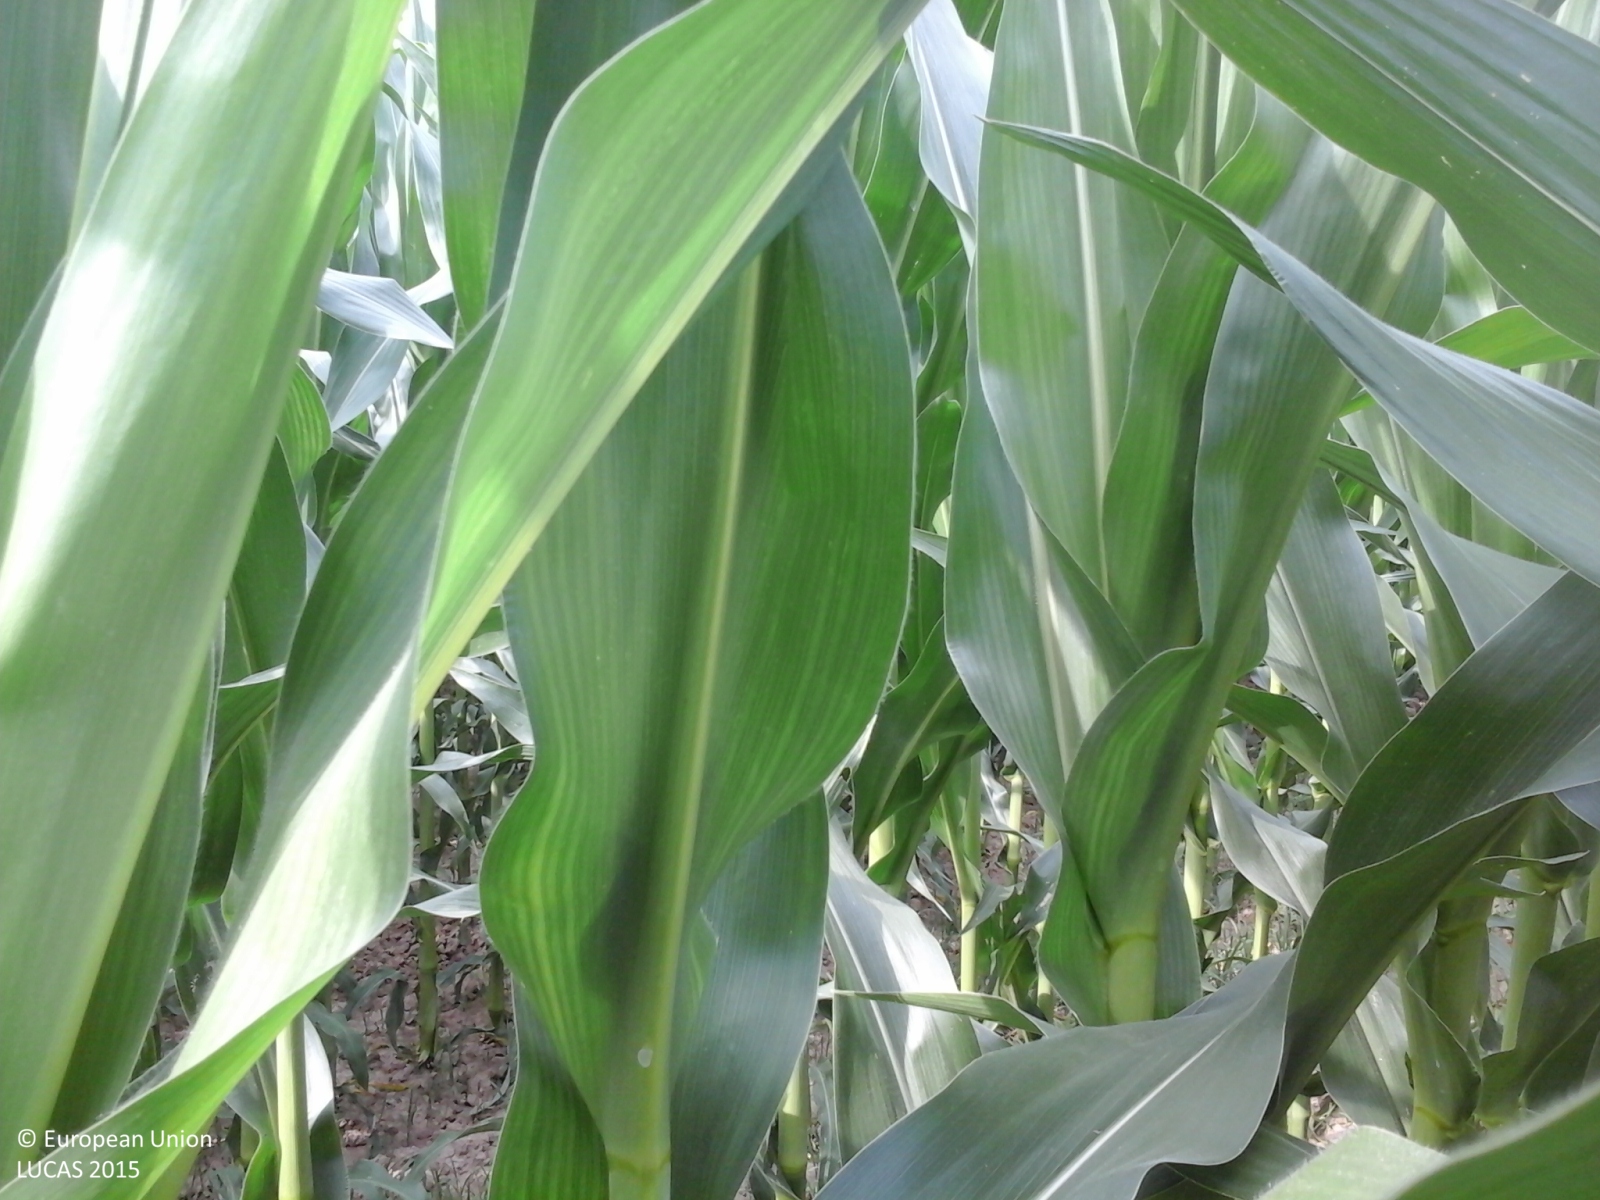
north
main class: Cropland
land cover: Maize
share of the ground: > 75 %
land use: Agriculture (excluding fallow land and kitchen gardens)
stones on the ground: < 10 %
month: June
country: IT
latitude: 45.2274
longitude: 11.1823
